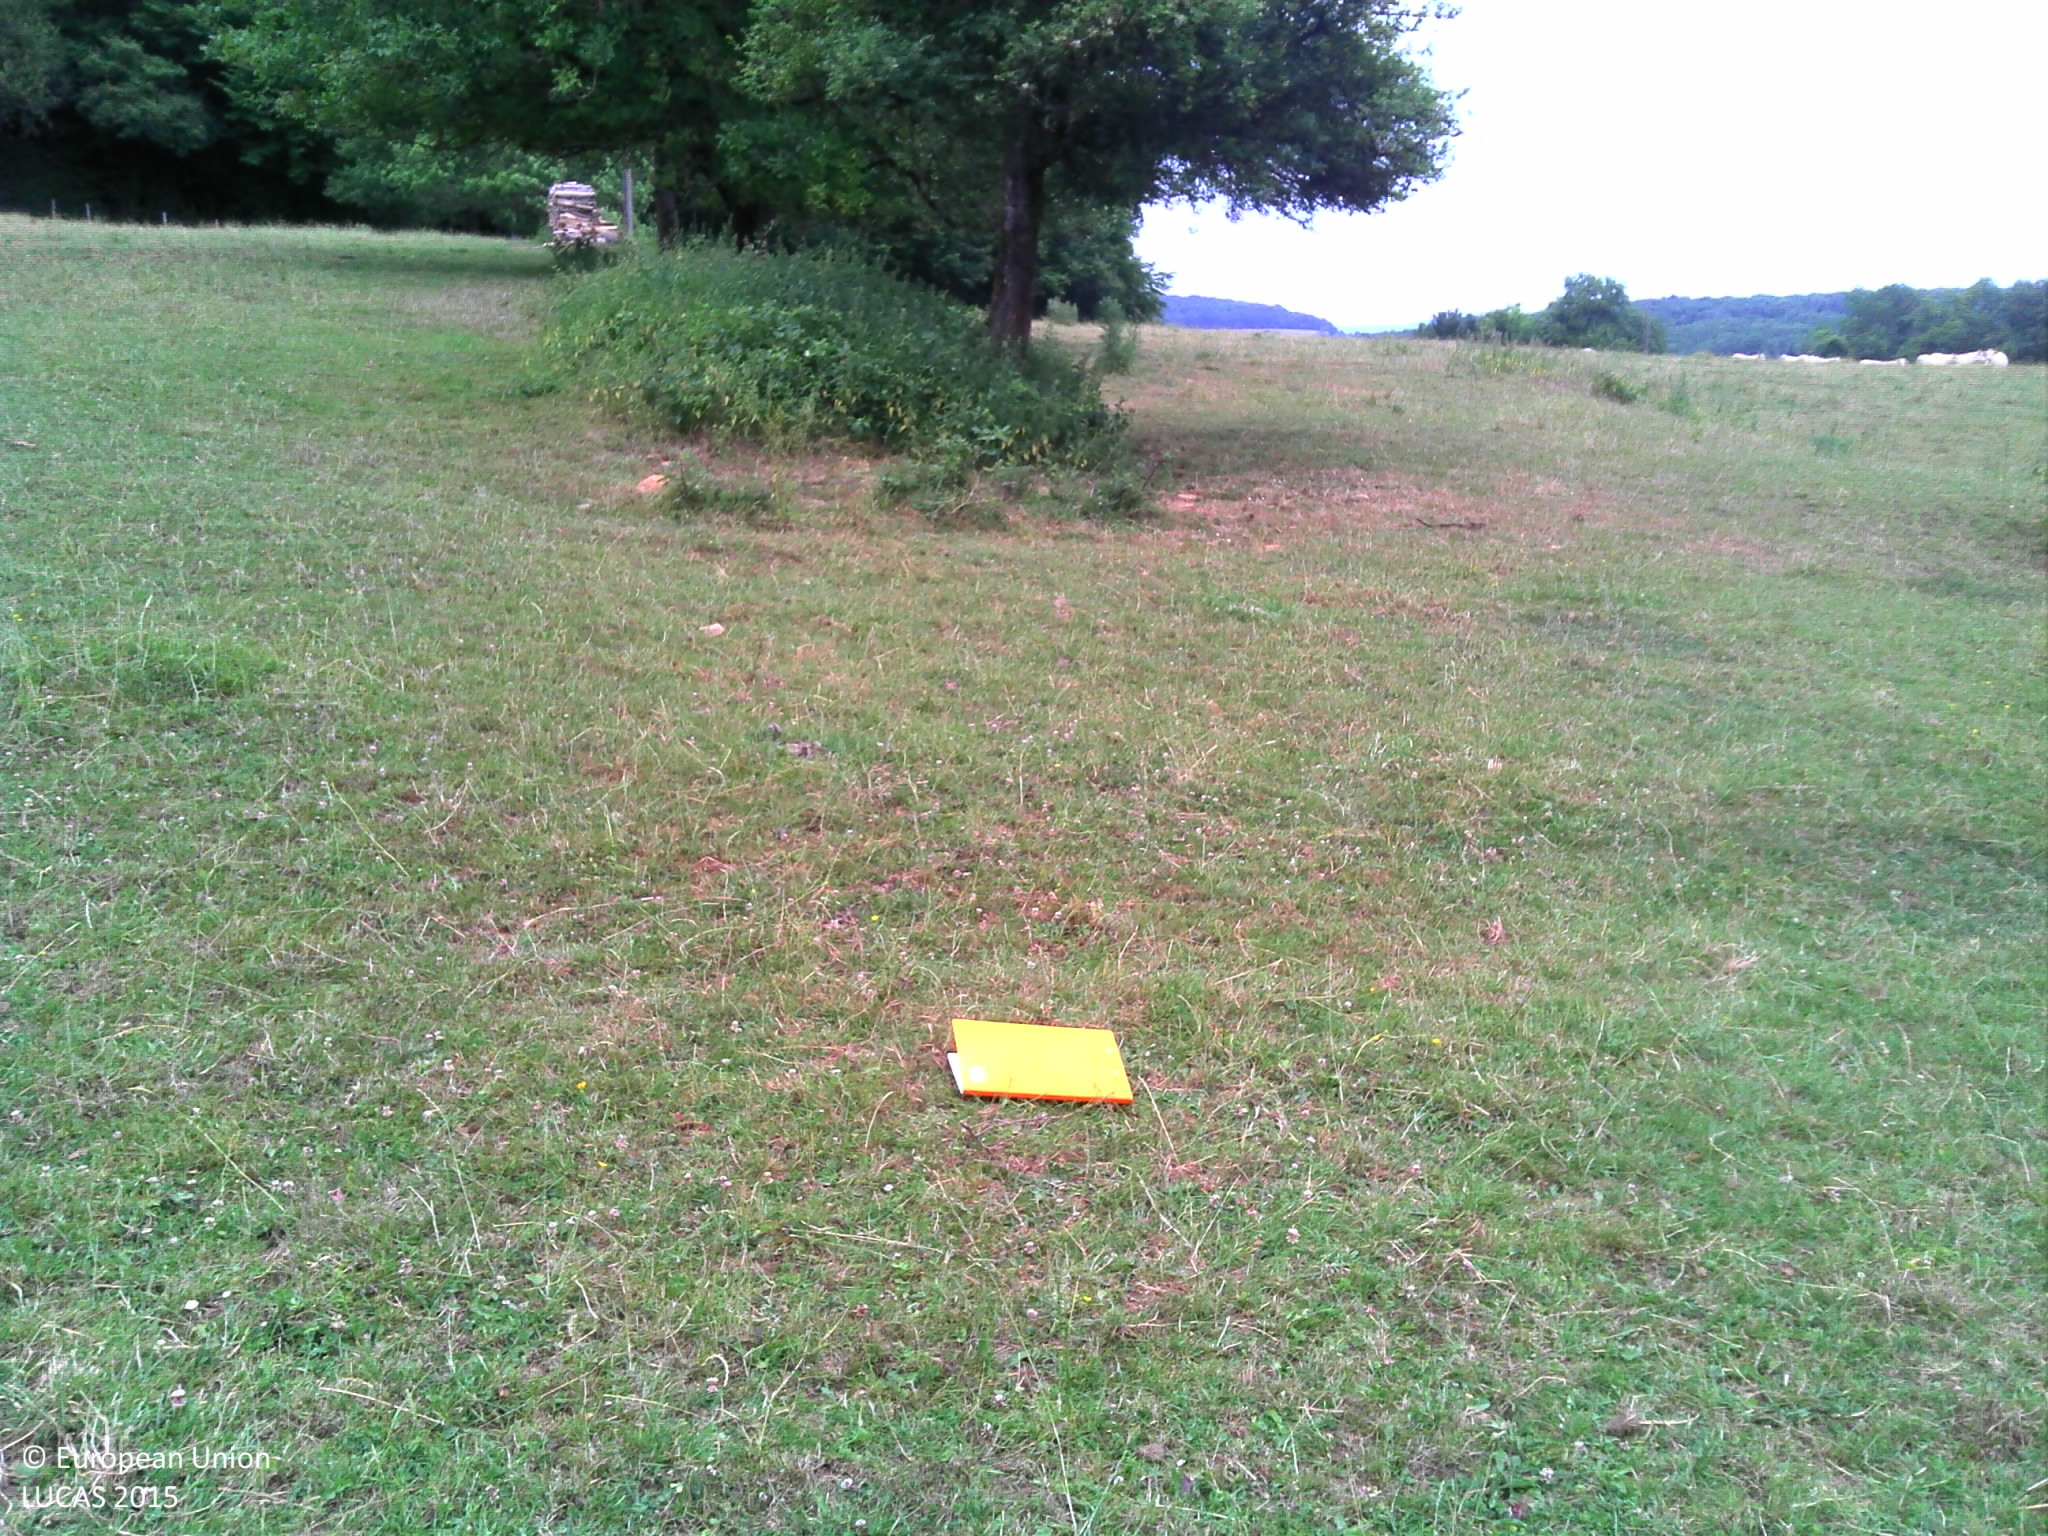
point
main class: Grassland
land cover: Grassland with sparse tree/shrub cover
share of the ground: > 75 %
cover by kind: herbaceous plants 95 %, broadleaved forest trees 5 %
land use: Agriculture (excluding fallow land and kitchen gardens)
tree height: > 5 m
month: June
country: FR
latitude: 47.5874
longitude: 6.3713
